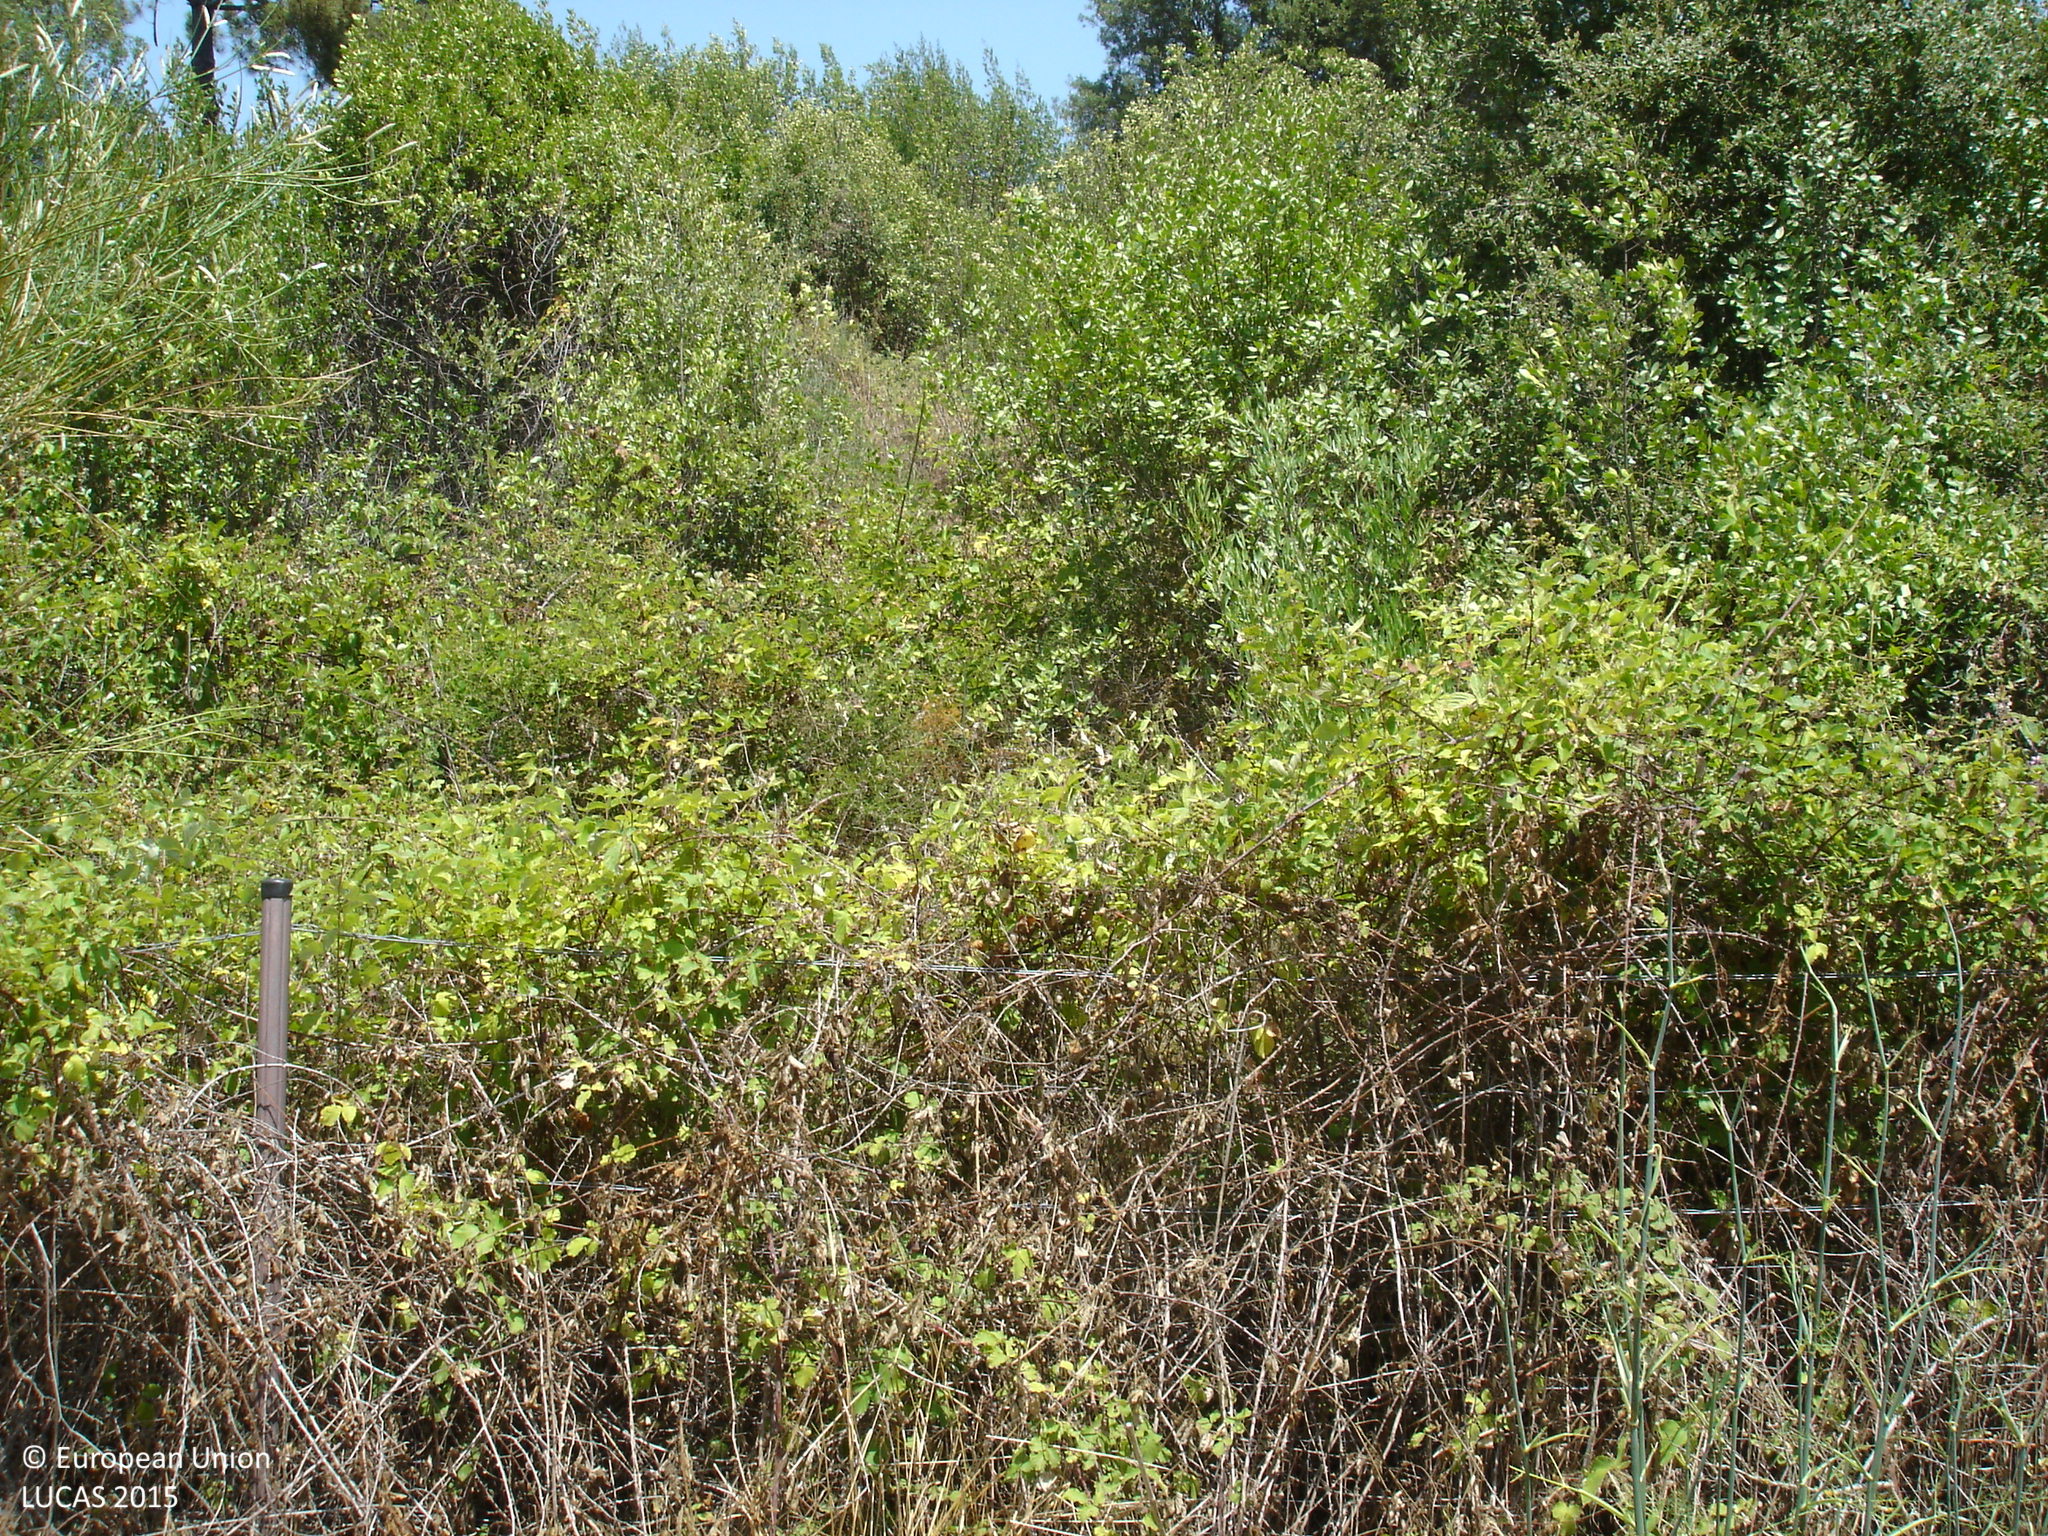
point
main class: Shrubland
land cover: Shrubland with sparse tree cover
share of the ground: > 75 %
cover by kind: shrubs 90 %, coniferous forest trees 5 %, herbaceous plants 5 %
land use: Semi-natural and natural areas not in use
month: July
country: ES
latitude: 41.9247
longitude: 3.0342
